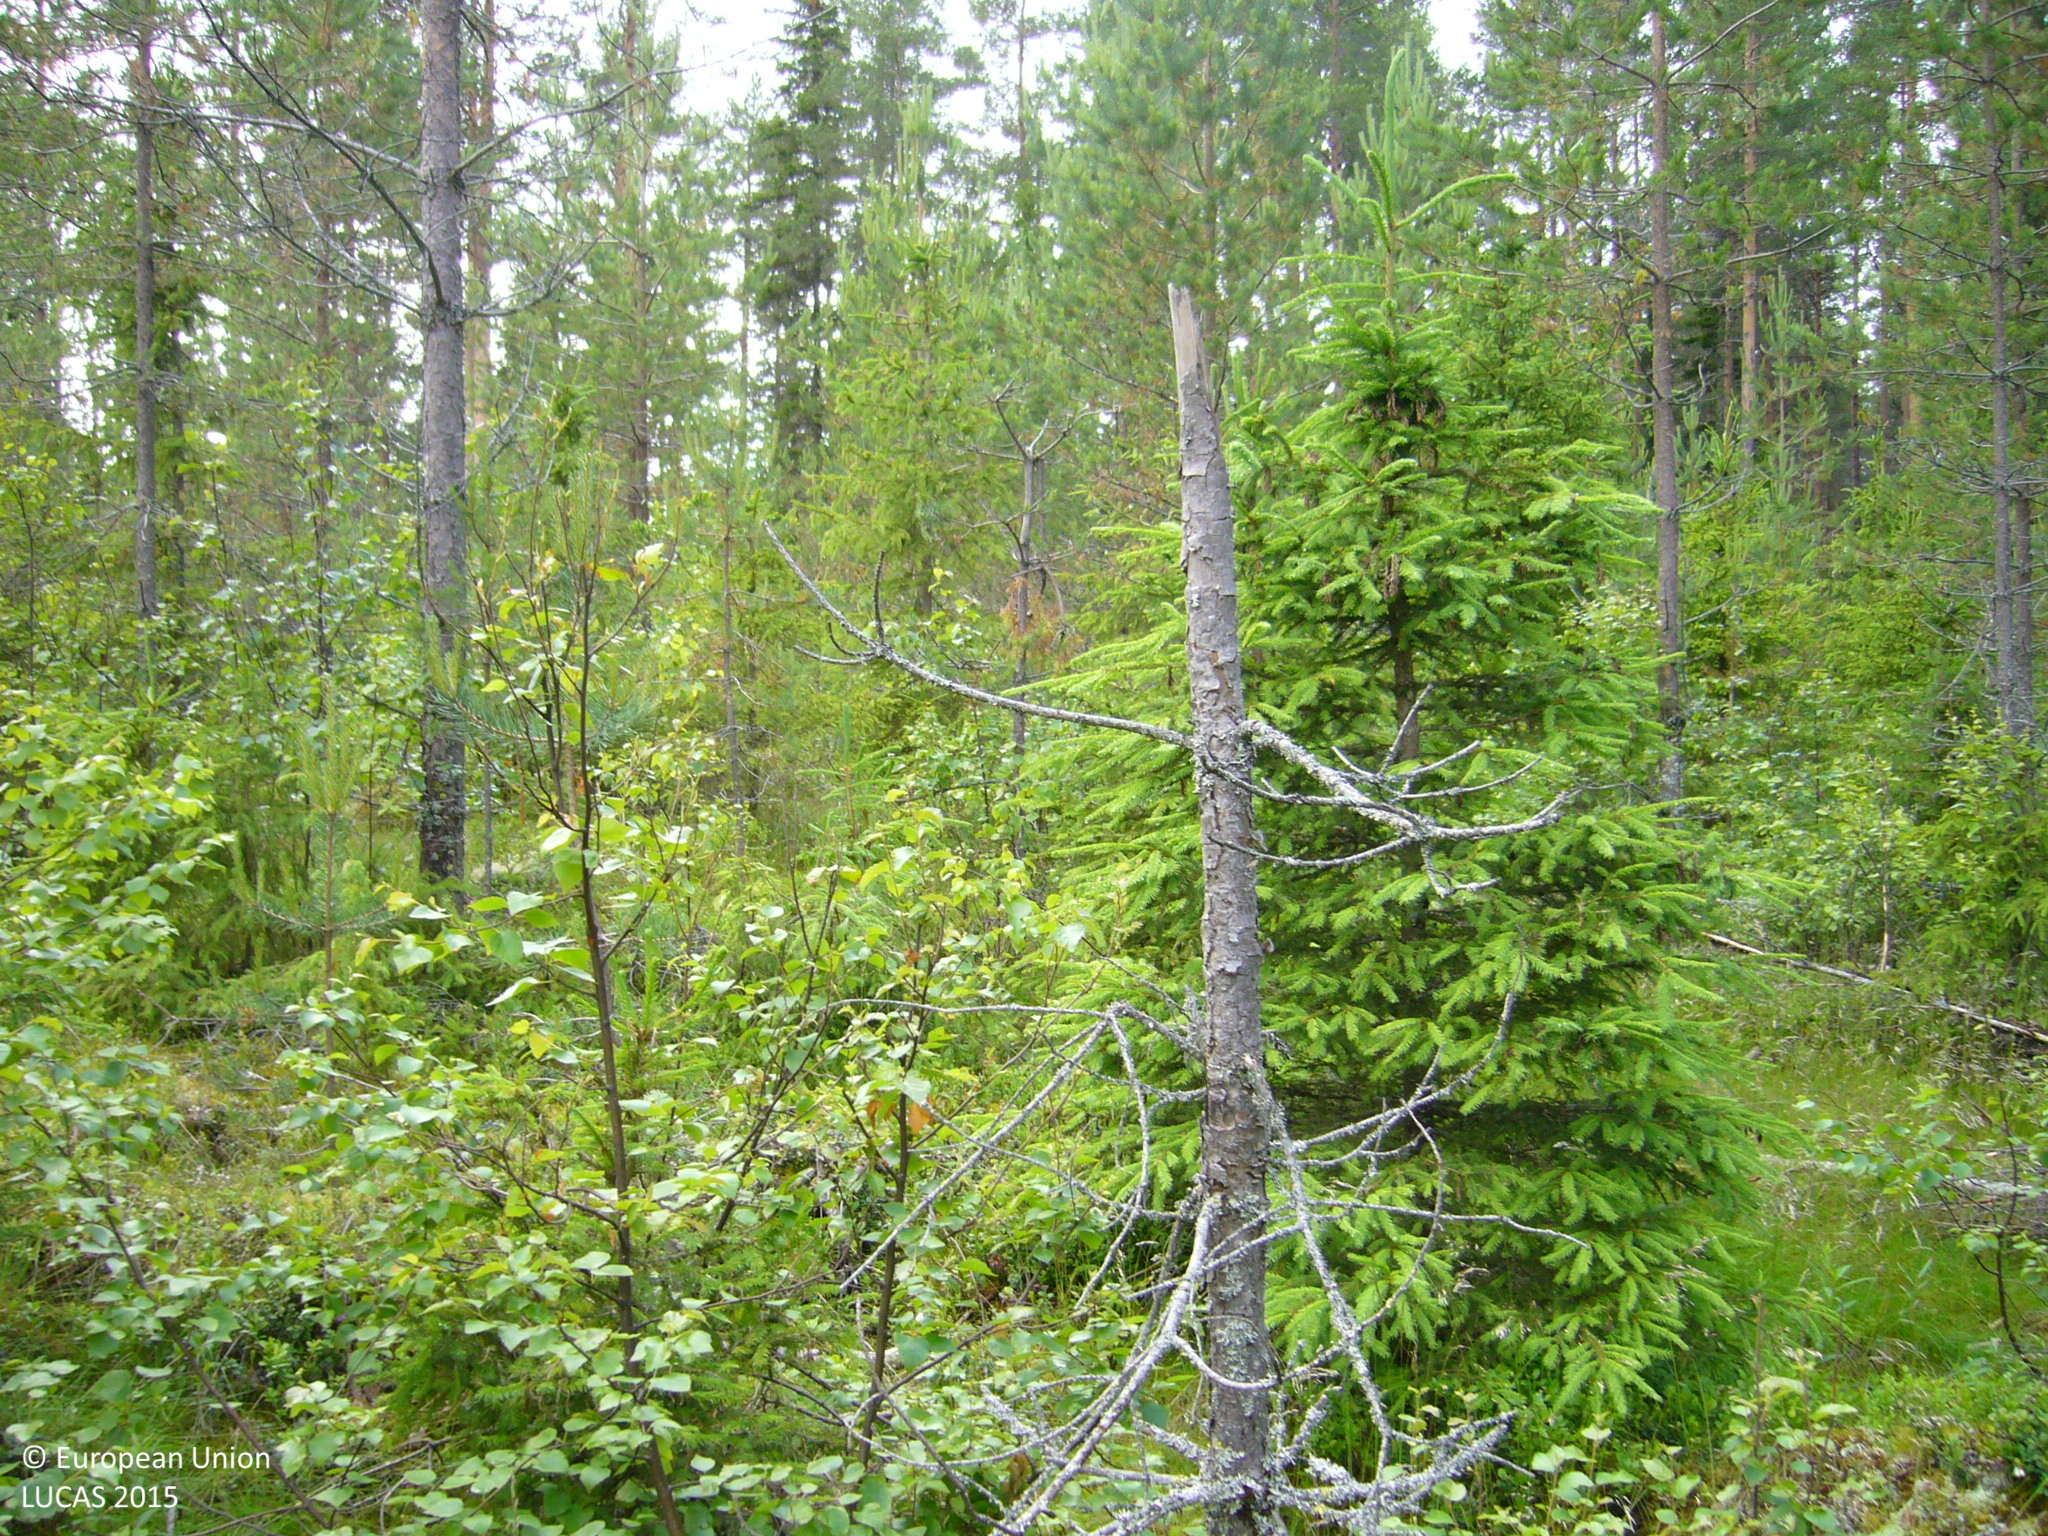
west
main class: Woodland
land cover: Spruce dominated mixed woodland
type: boreal forest
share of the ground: 50 - 75 %
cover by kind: shrubs 45 %, coniferous forest trees 30 %, broadleaved forest trees 25 %
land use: Forestry
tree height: > 5 m
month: July
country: FI
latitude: 63.5074
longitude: 25.4307
